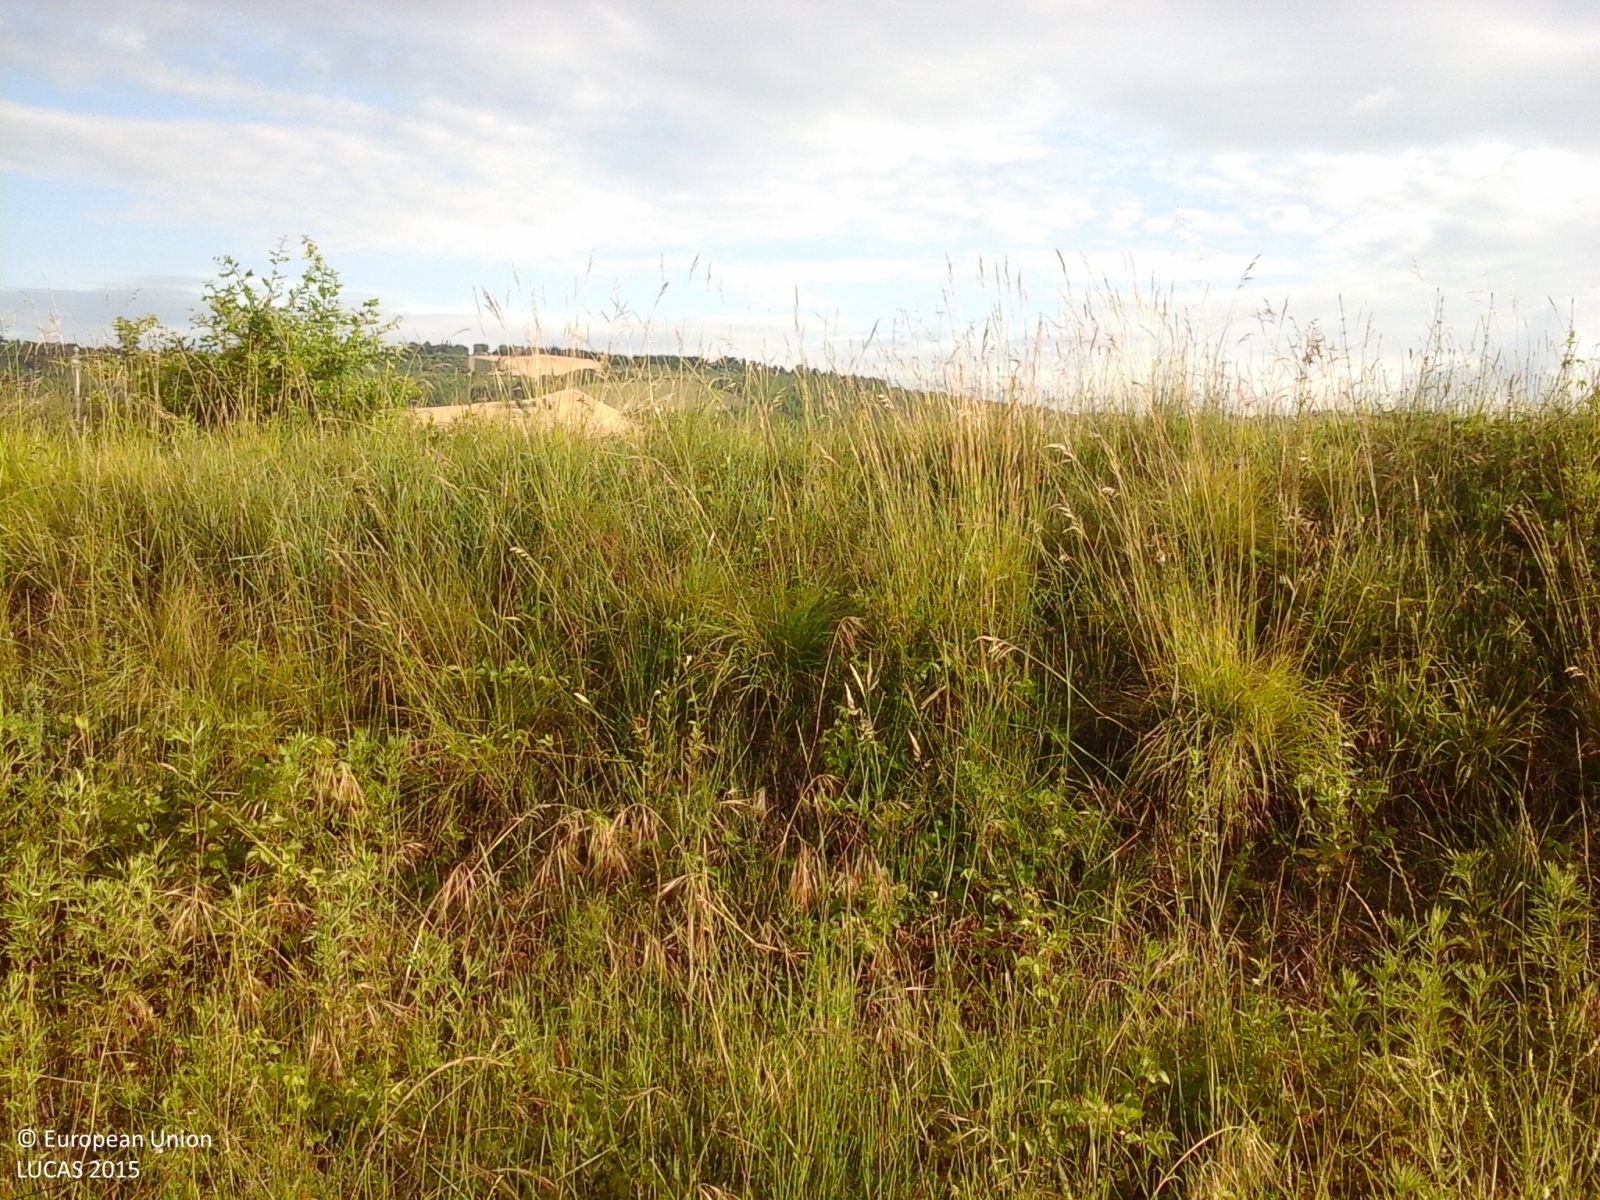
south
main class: Grassland
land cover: Grassland without tree/shrub cover
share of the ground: 50 - 75 %
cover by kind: herbaceous plants 100 %
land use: Agriculture (excluding fallow land and kitchen gardens)
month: June
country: IT
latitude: 43.3531
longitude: 13.4828
